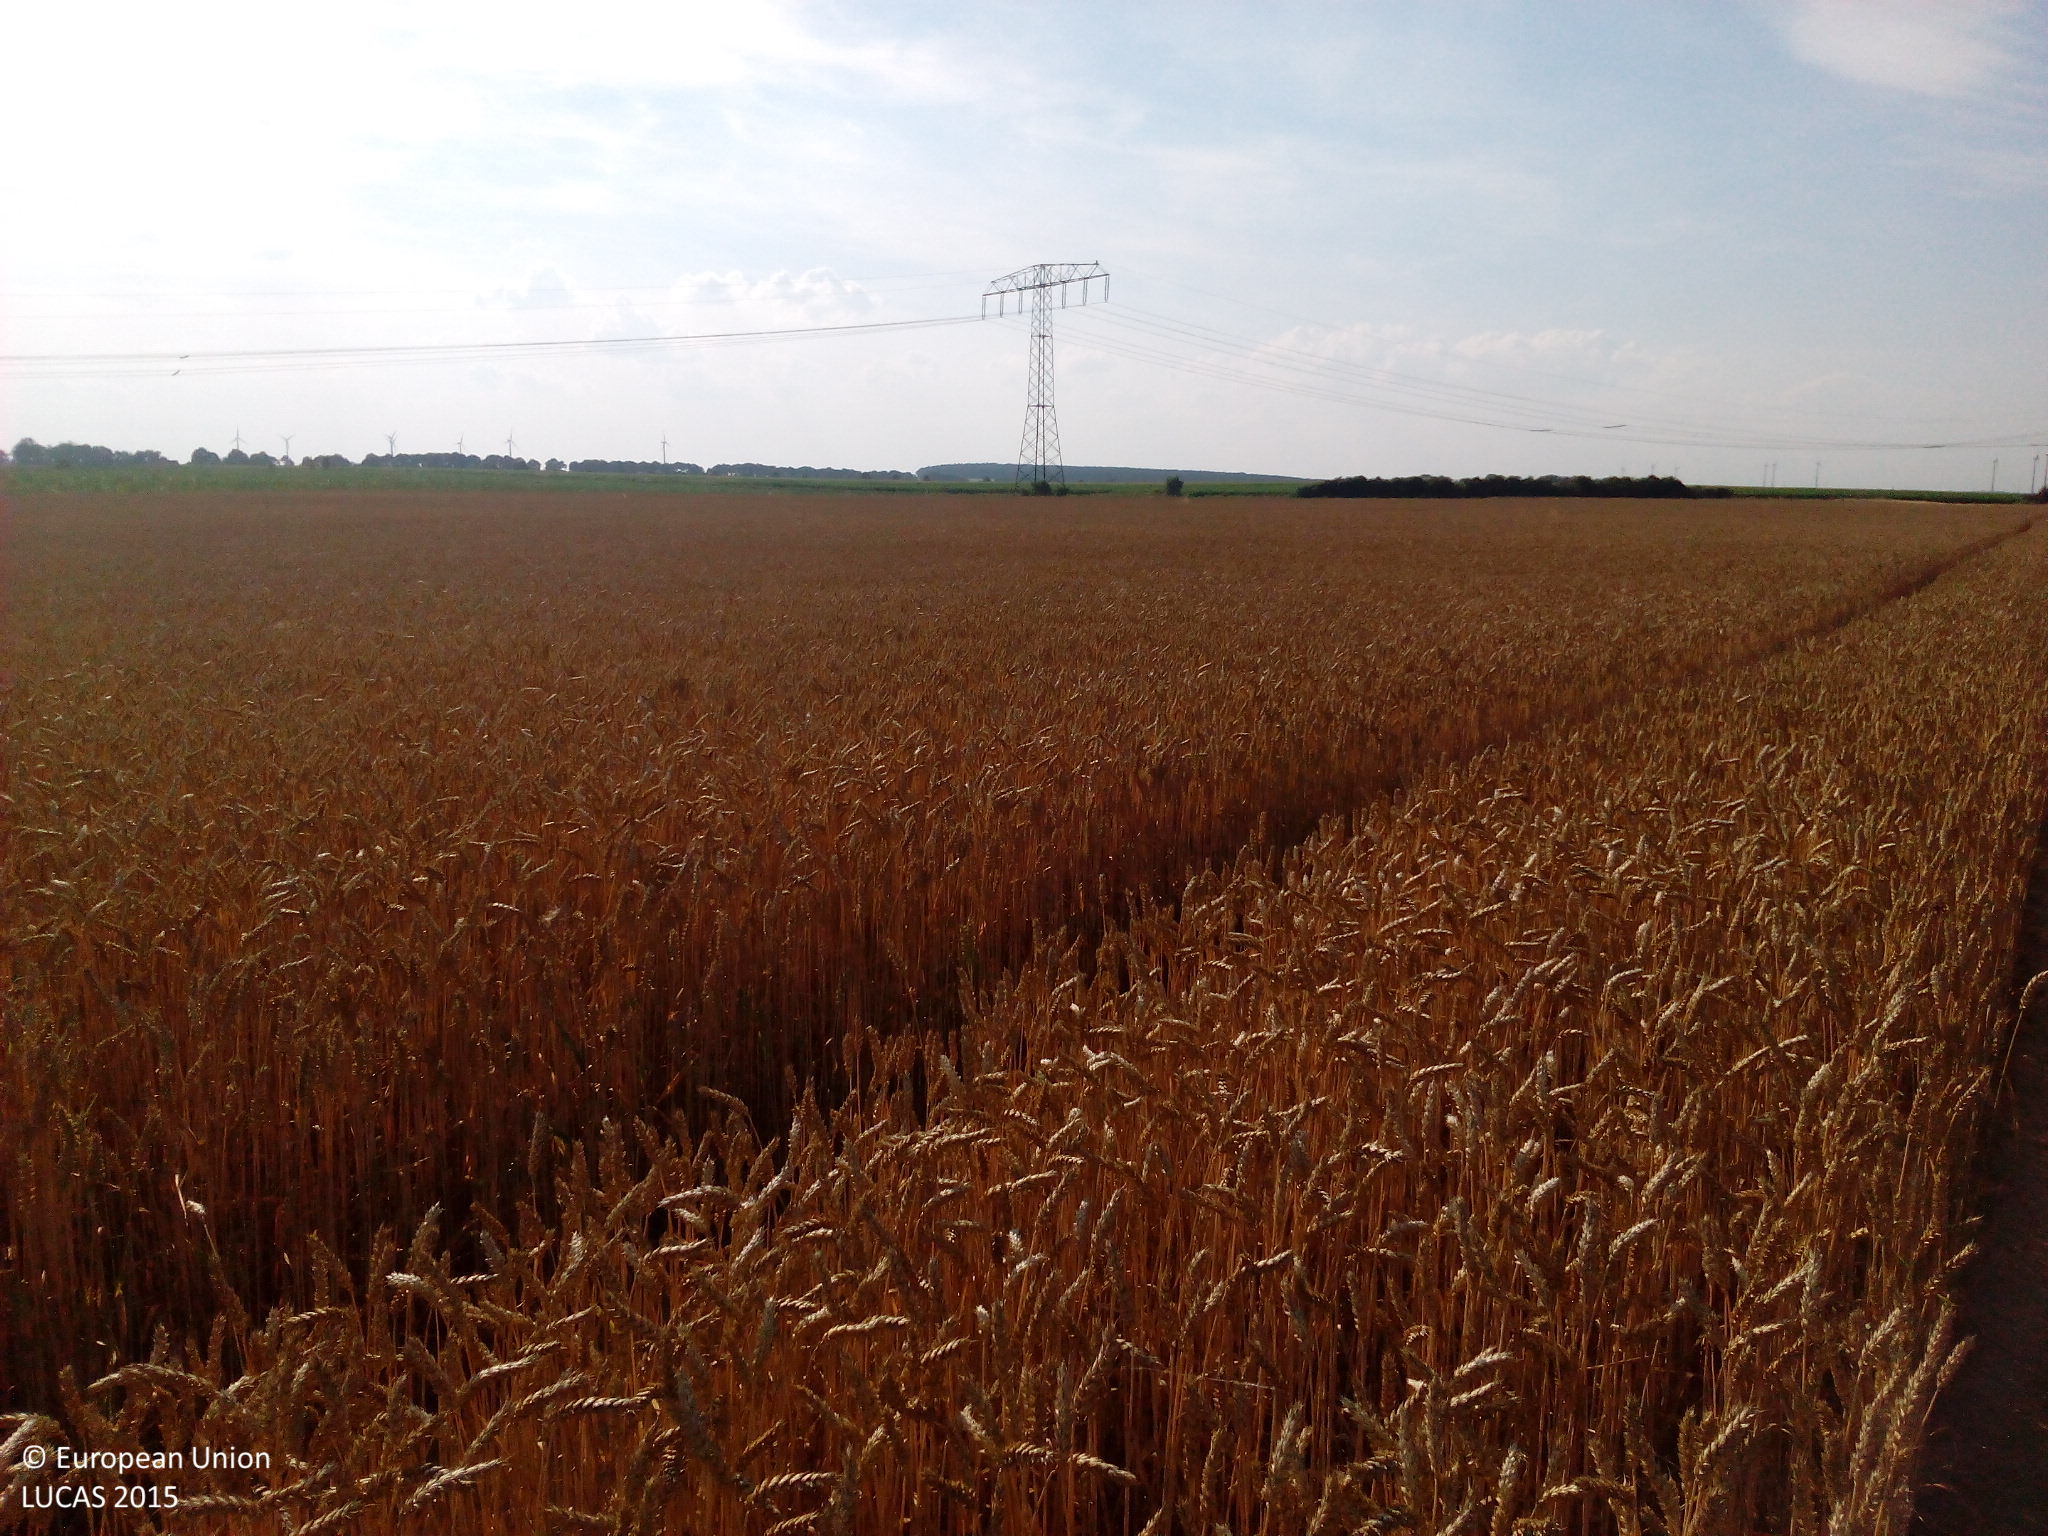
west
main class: Cropland
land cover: Common wheat
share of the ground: > 75 %
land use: Agriculture (excluding fallow land and kitchen gardens)
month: August
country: DE
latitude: 53.6180
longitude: 13.6129
